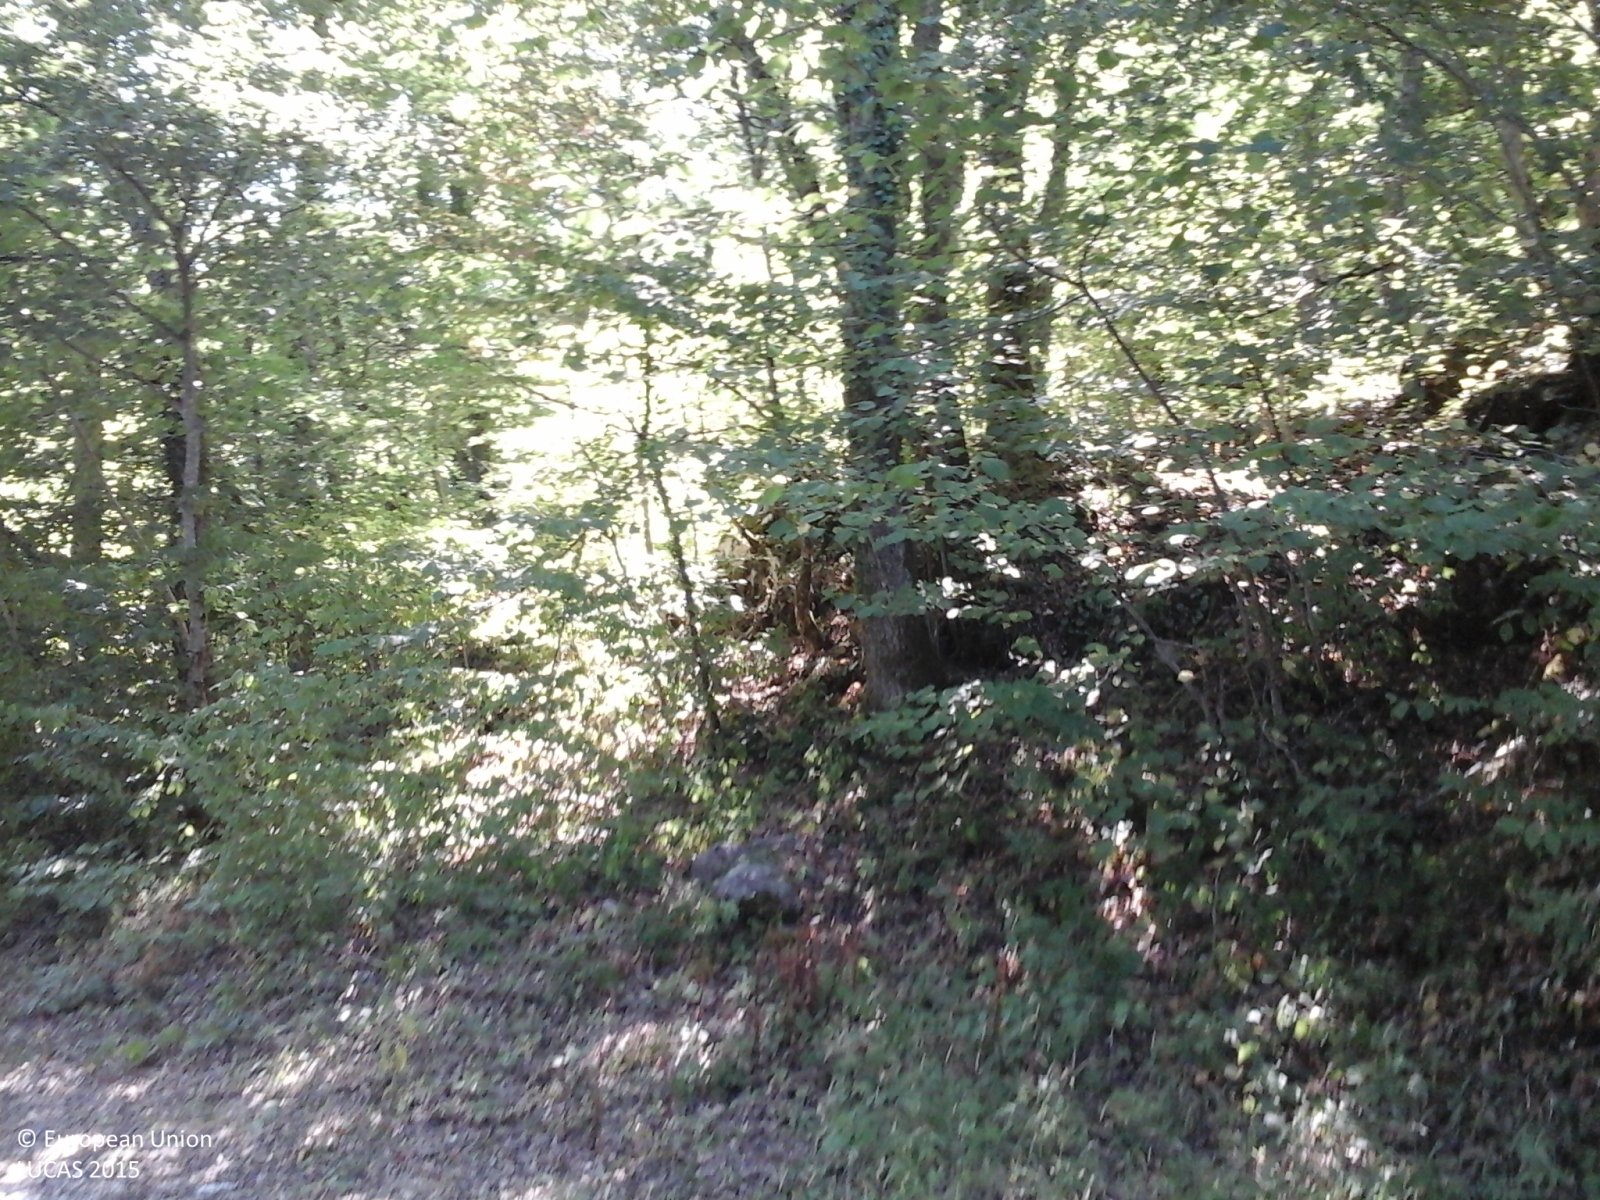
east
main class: Woodland
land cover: Broadleaved woodland
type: thermophilous deciduous forest
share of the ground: > 75 %
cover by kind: broadleaved forest trees 75 %, shrubs 15 %, herbaceous plants 10 %
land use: Semi-natural and natural areas not in use
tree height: > 5 m
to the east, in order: Broadleaved woodland; Grassland without tree/shrub cover; Rock outcrops; Broadleaved woodland
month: August
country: IT
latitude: 41.6552
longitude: 14.3677
